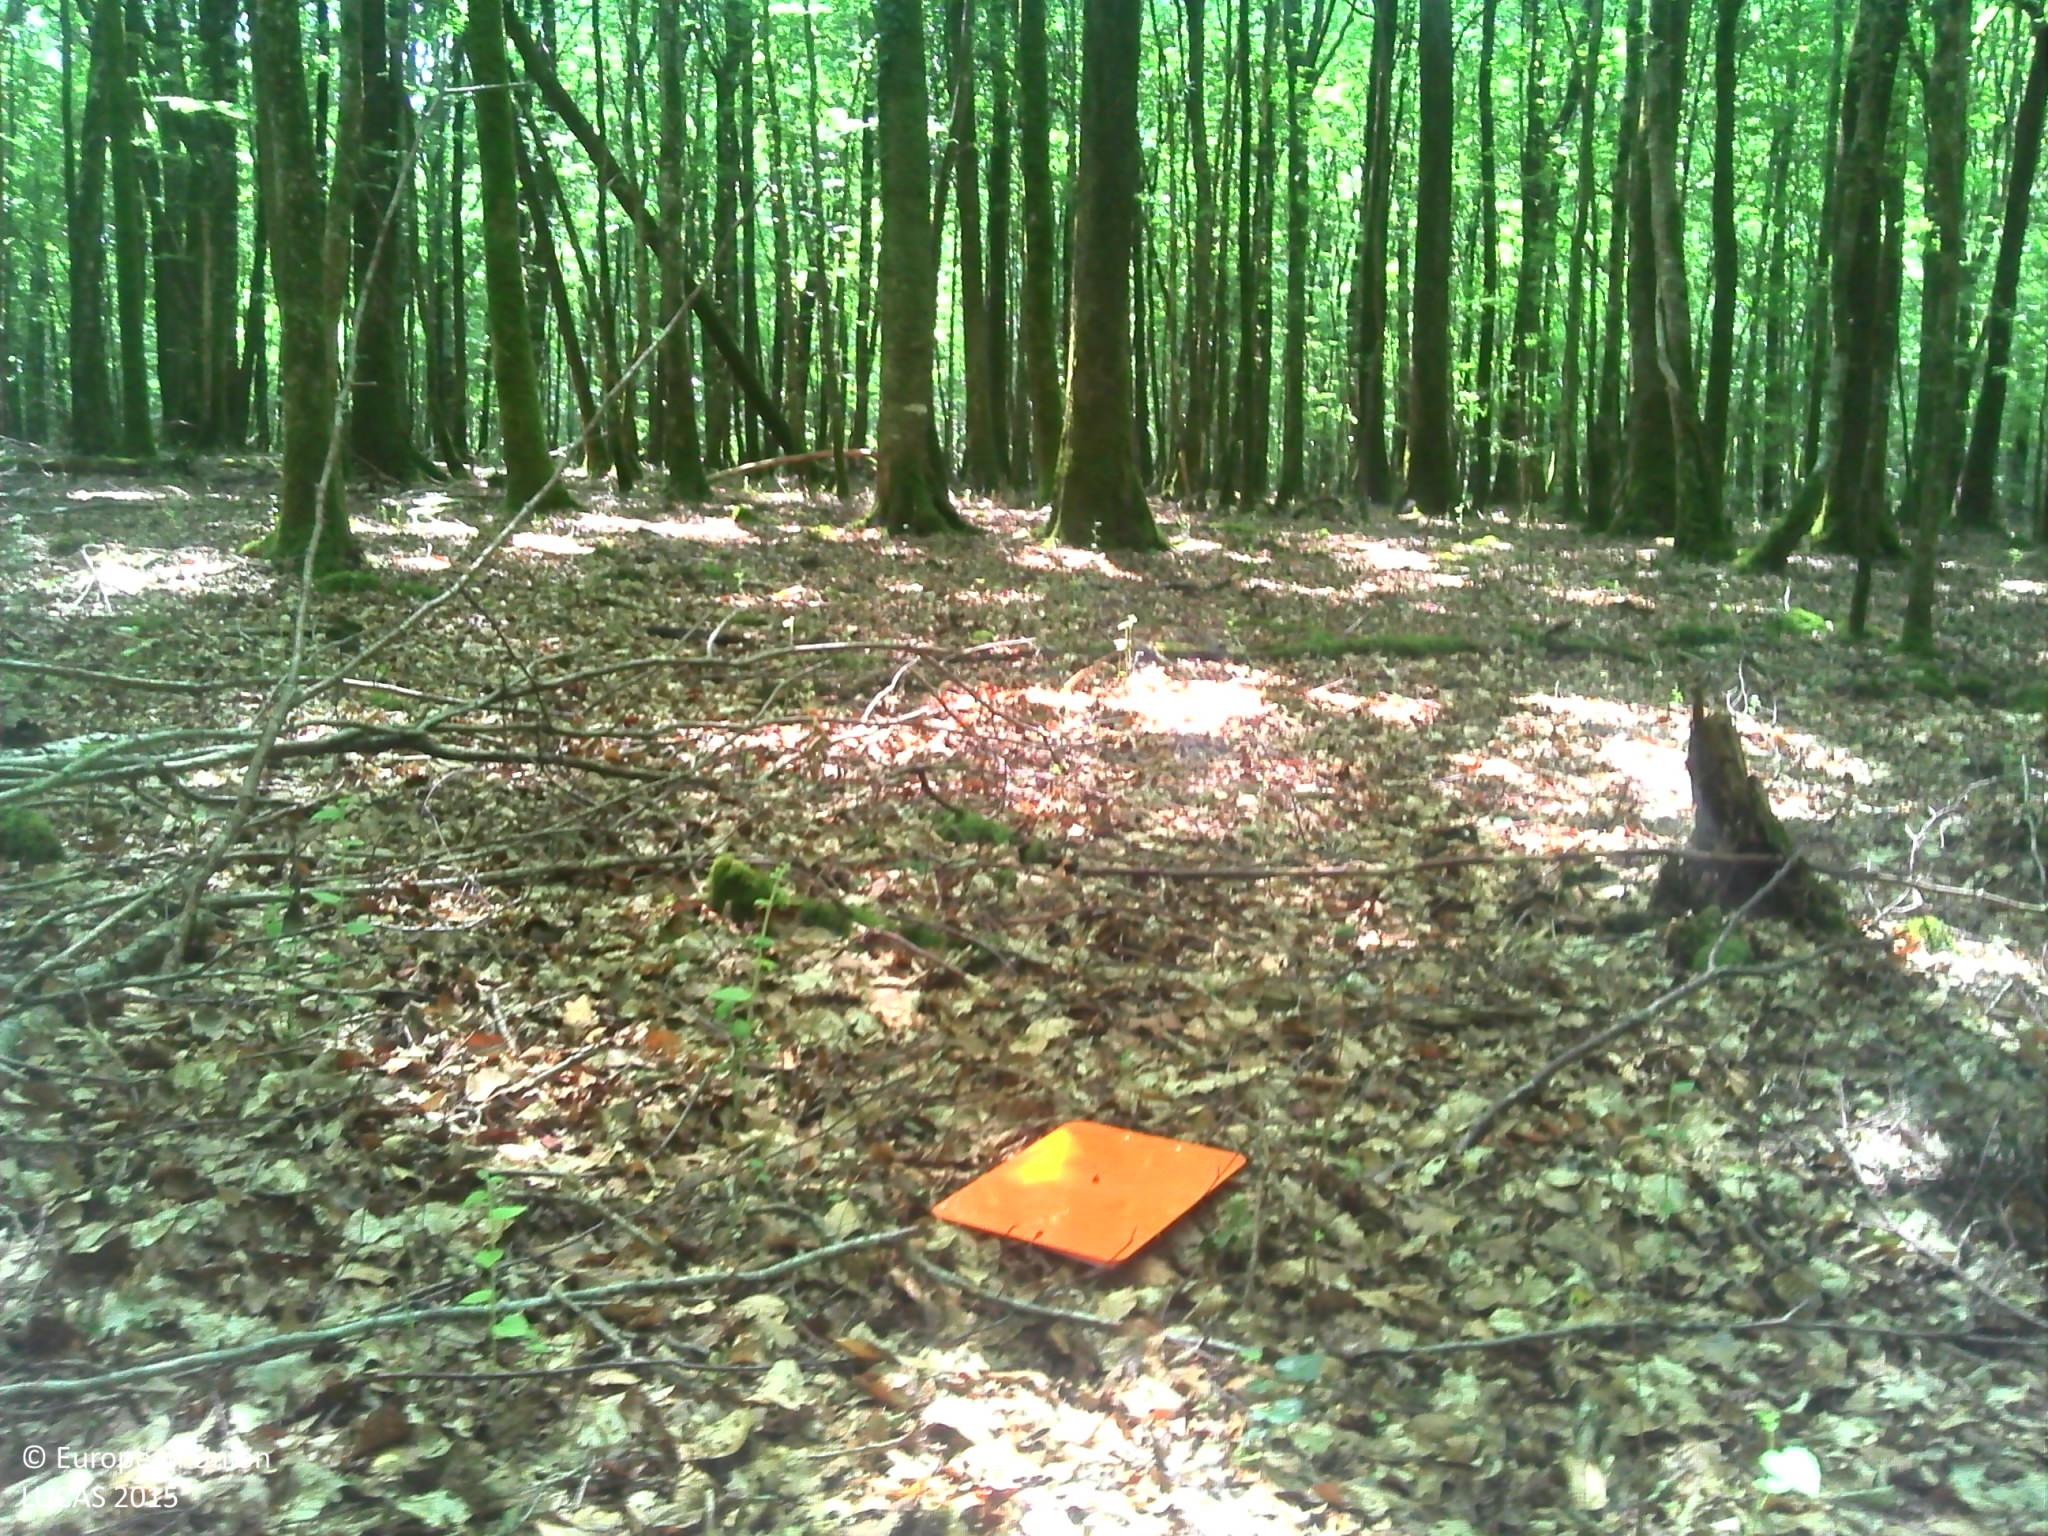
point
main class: Woodland
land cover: Broadleaved woodland
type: acidophilous oak and oak-birch forest
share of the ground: > 75 %
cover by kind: broadleaved forest trees 90 %, herbaceous plants 5 %, lichens and mosses 5 %
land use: Forestry
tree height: > 5 m
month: July
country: FR
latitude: 48.1147
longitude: 0.8588
